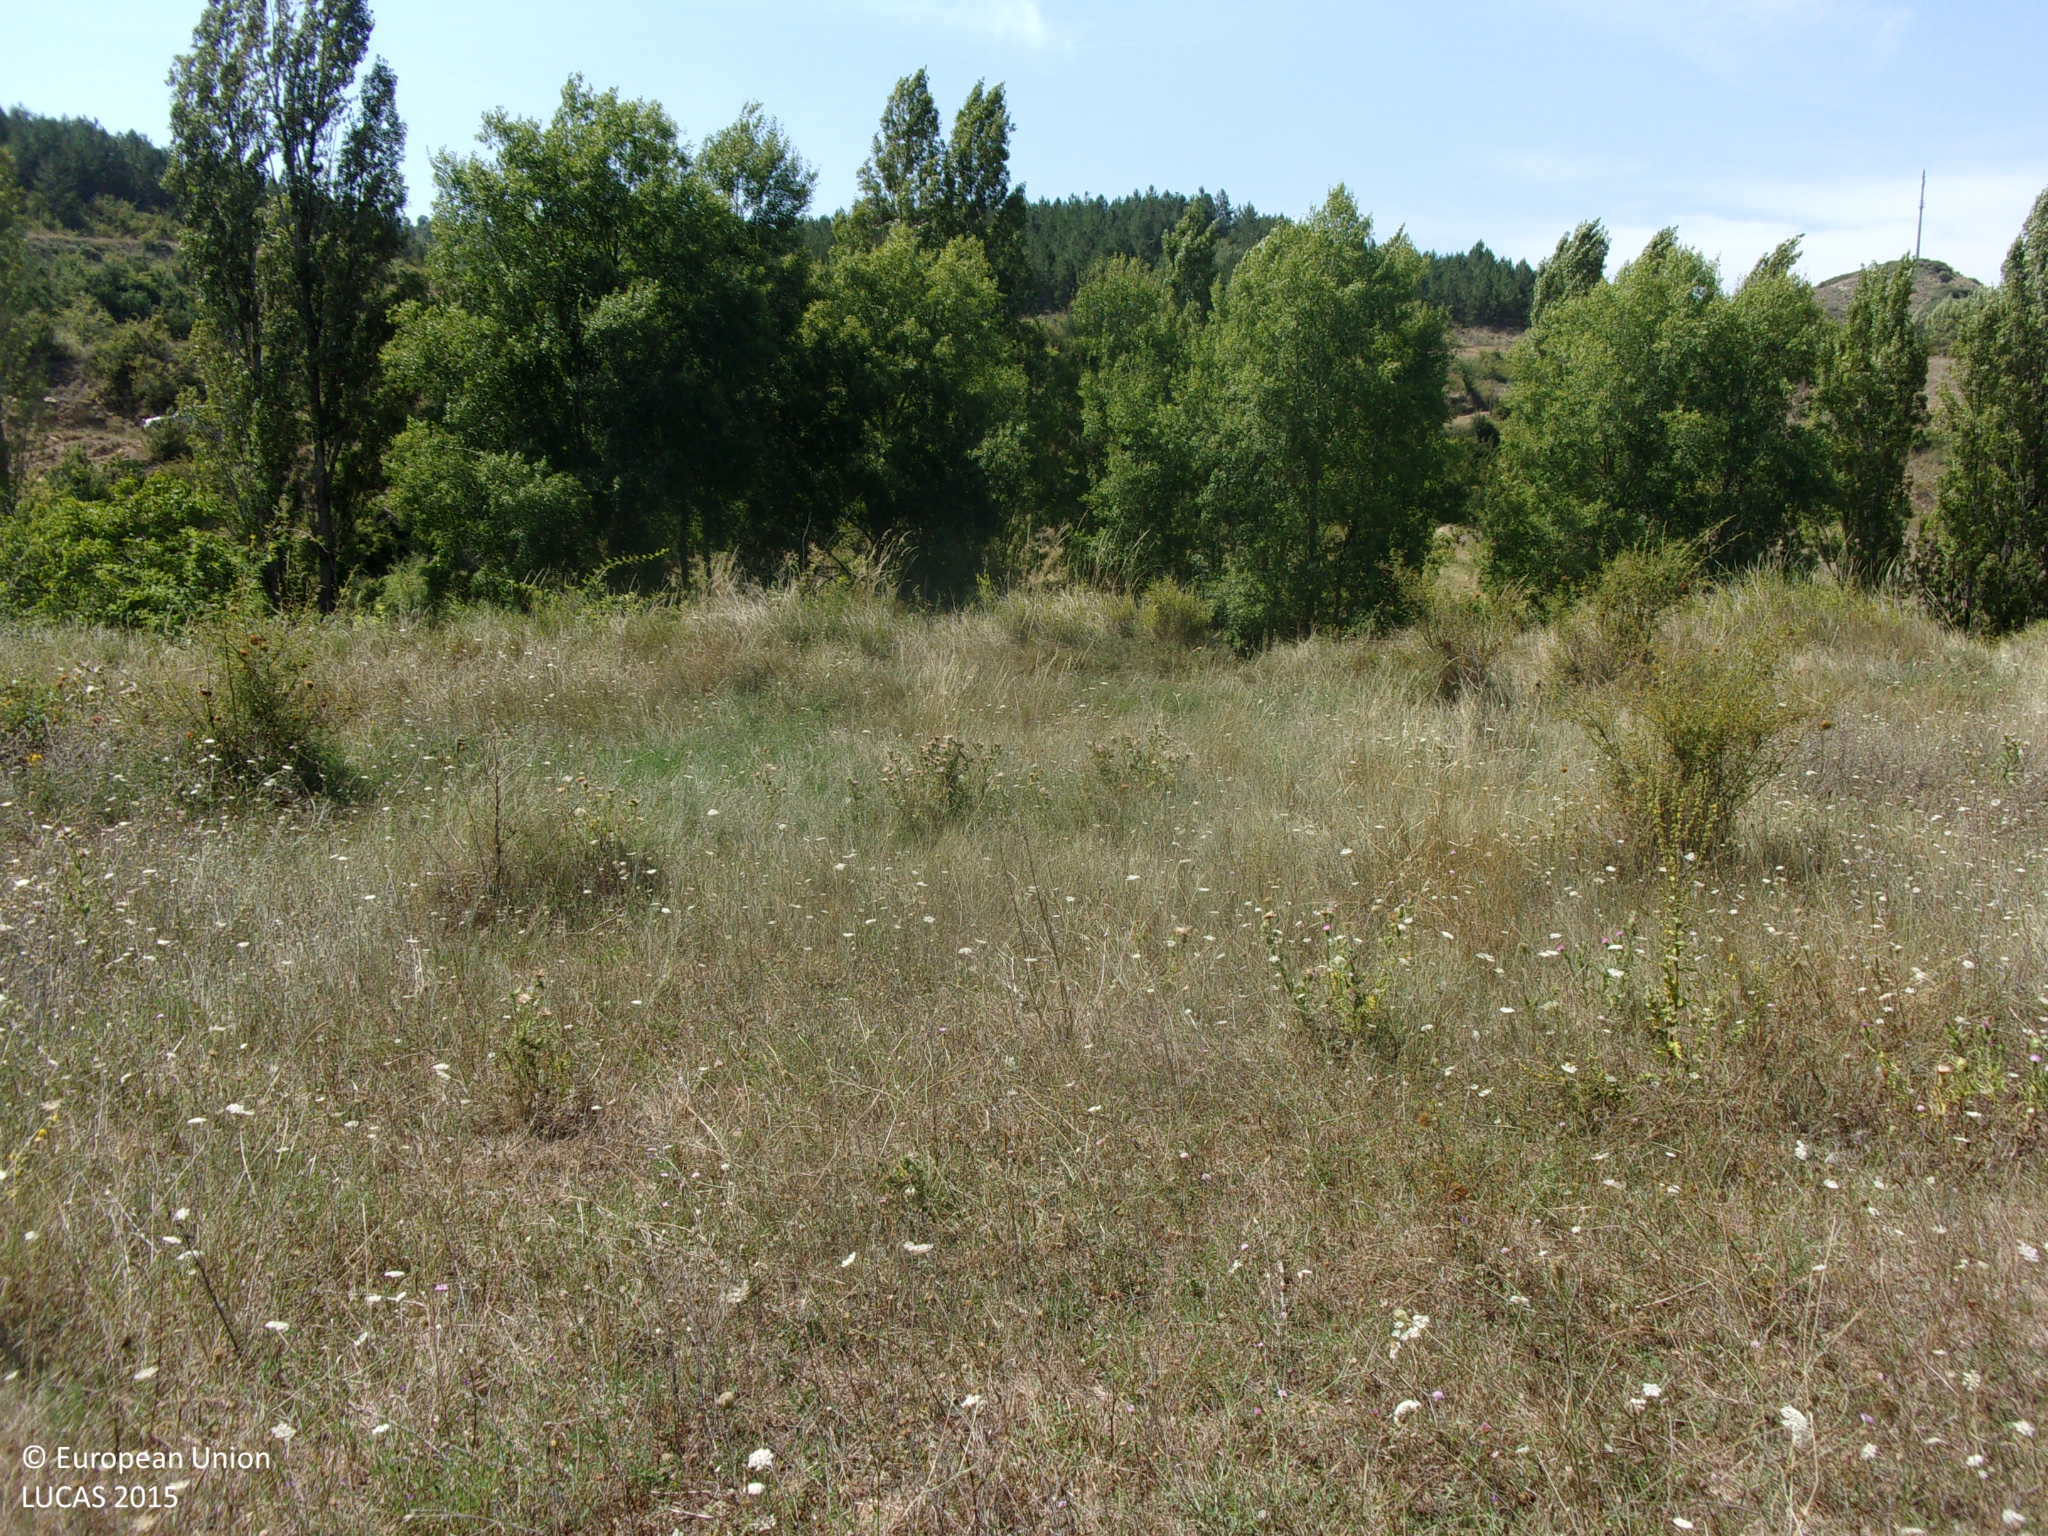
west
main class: Grassland
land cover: Spontaneously vegetated surfaces
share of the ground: > 75 %
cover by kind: herbaceous plants 100 %
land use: Abandoned areas
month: August
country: ES
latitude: 42.4848
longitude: -1.2122
